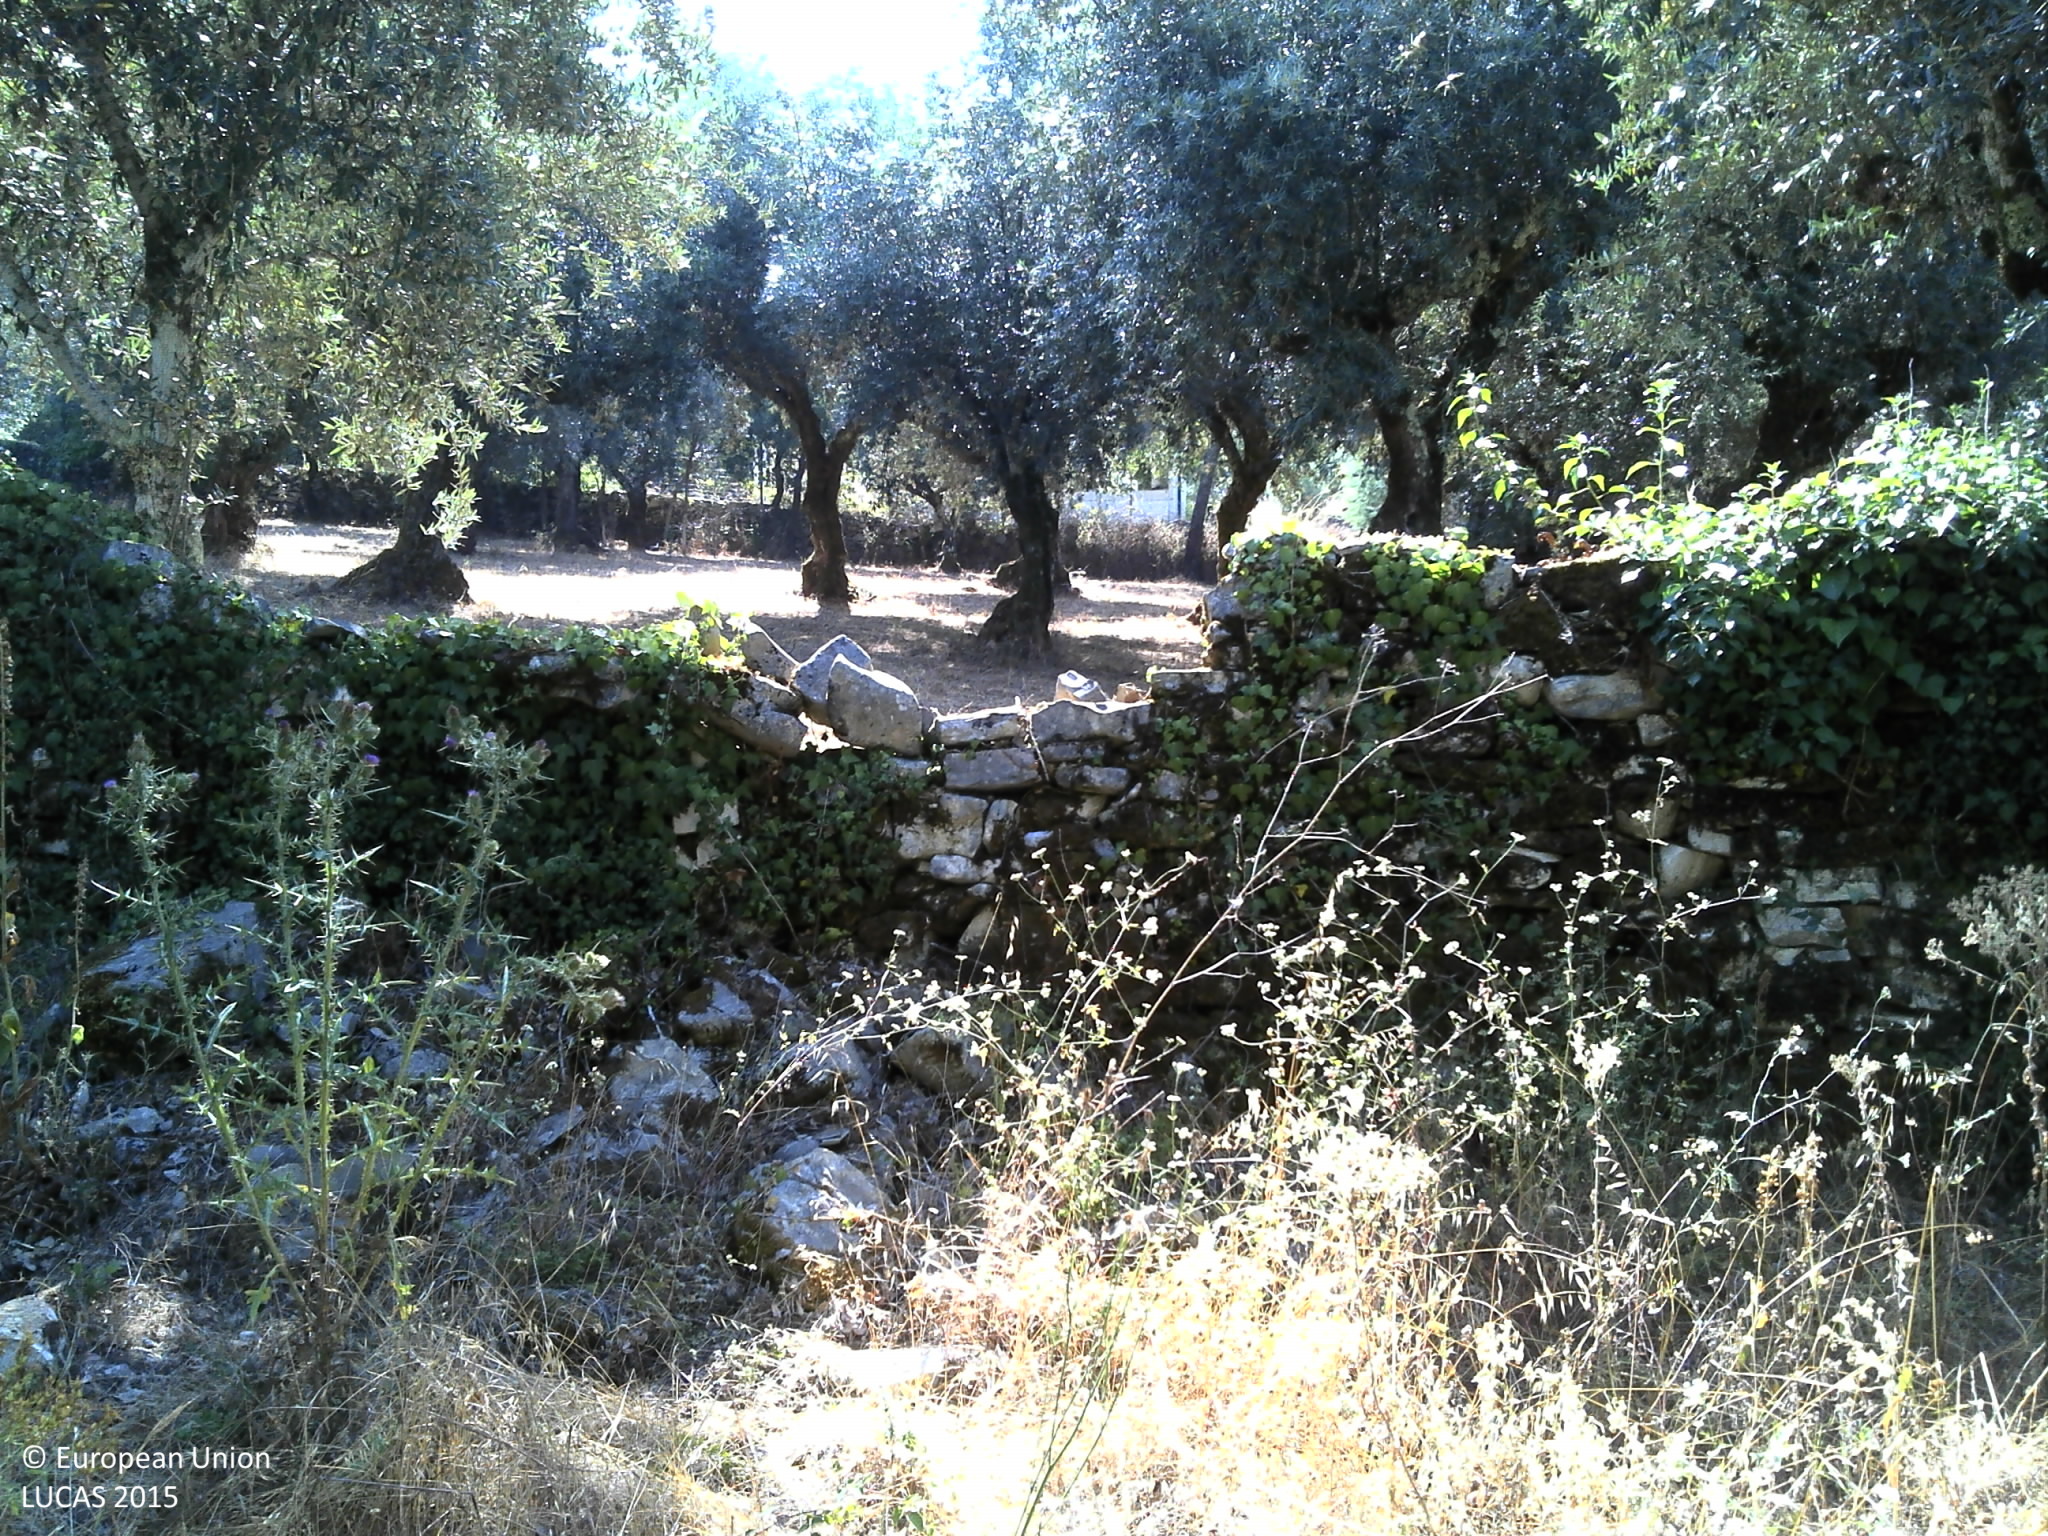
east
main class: Woodland
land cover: Broadleaved woodland
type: broadleaved evergreen forest
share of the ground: 10 - 25 %
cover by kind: herbaceous plants 80 %, broadleaved forest trees 20 %
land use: Forestry
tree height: > 5 m
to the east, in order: Broadleaved woodland; Grassland without tree/shrub cover; Broadleaved woodland; Dry stone walls; Olive groves; Dry stone walls; Fences; Artificial constructions in urban areas; Broadleaved woodland; Fences; Olive groves; Artificial constructions in urban areas; Olive groves; Grassland without tree/shrub cover; Dry stone walls; Grassland without tree/shrub cover; Electric lines; Grassland without tree/shrub cover; Artificial constructions in urban areas
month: July
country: PT
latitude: 39.9053
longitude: -8.4550
